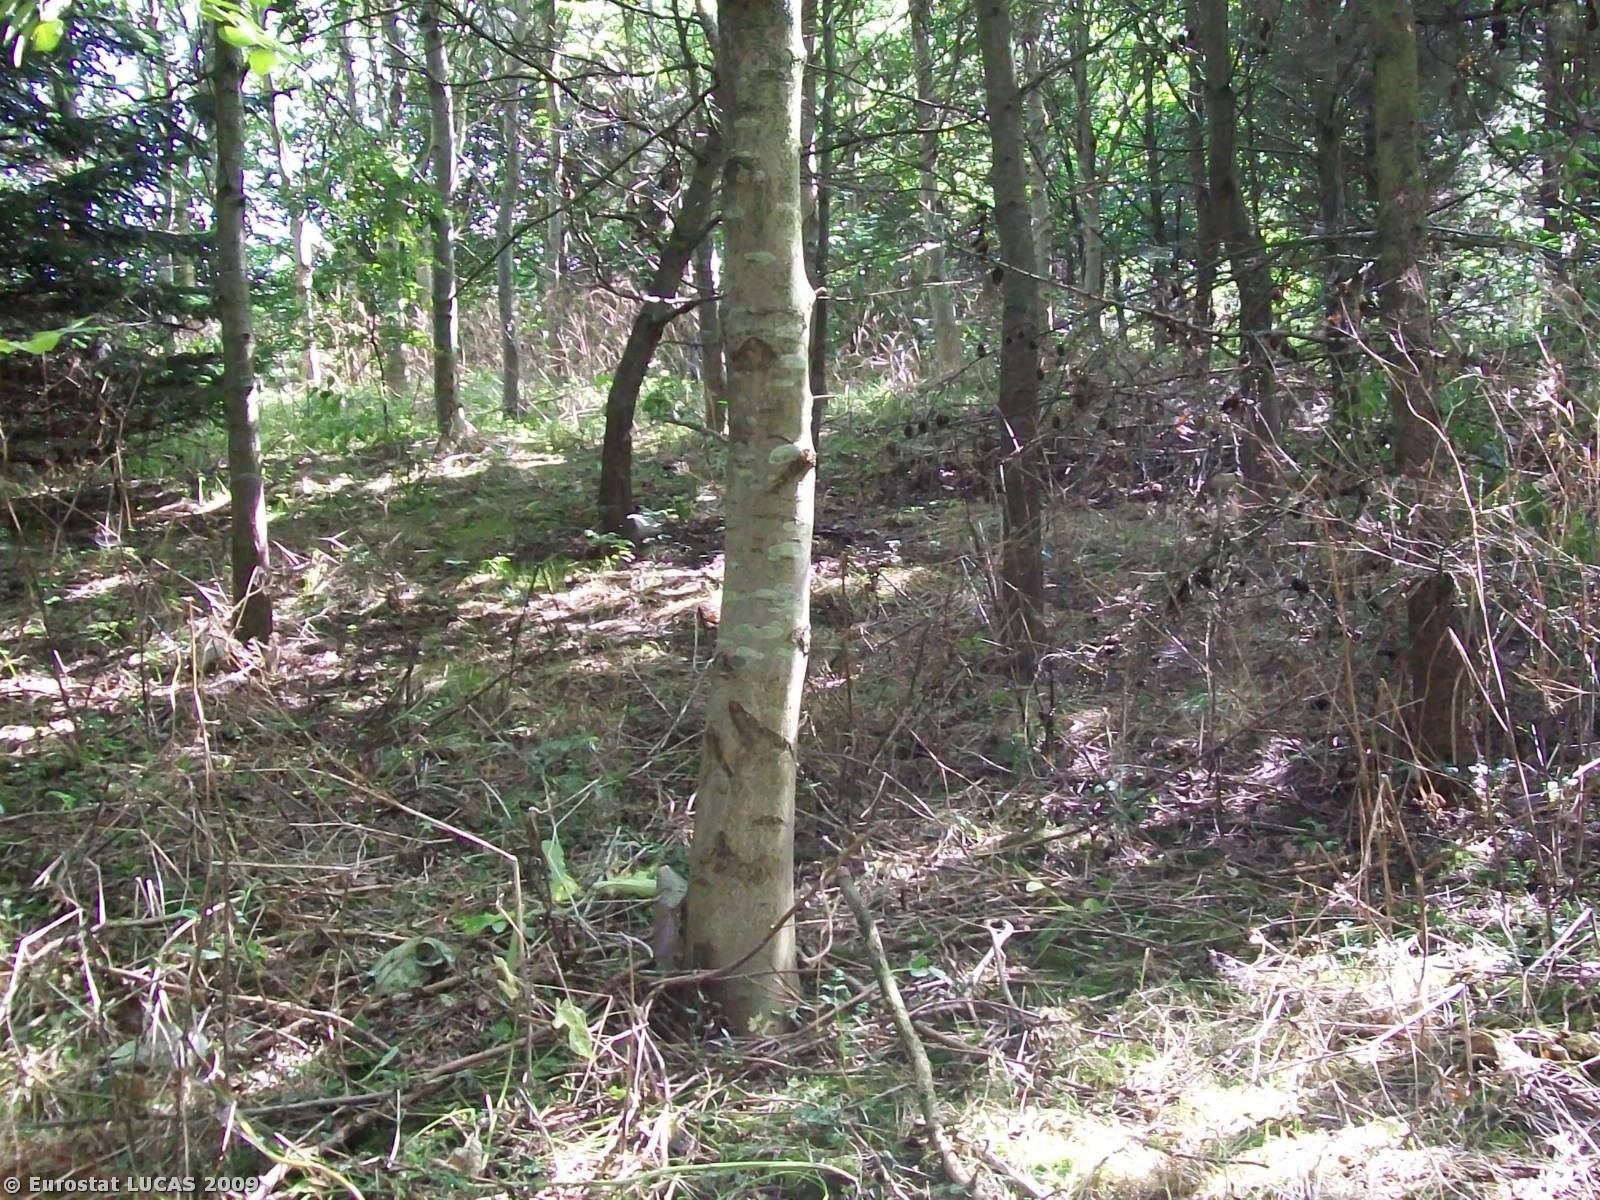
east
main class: Woodland
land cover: Broadleaved woodland
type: mesophytic deciduous forest
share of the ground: > 75 %
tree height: > 5 m
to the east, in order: Broadleaved woodland; Fences; Grassland without tree/shrub cover; Fences; Broadleaved woodland; Fences; Grassland without tree/shrub cover
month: August
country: GB
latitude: 52.4927
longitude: -1.0767
